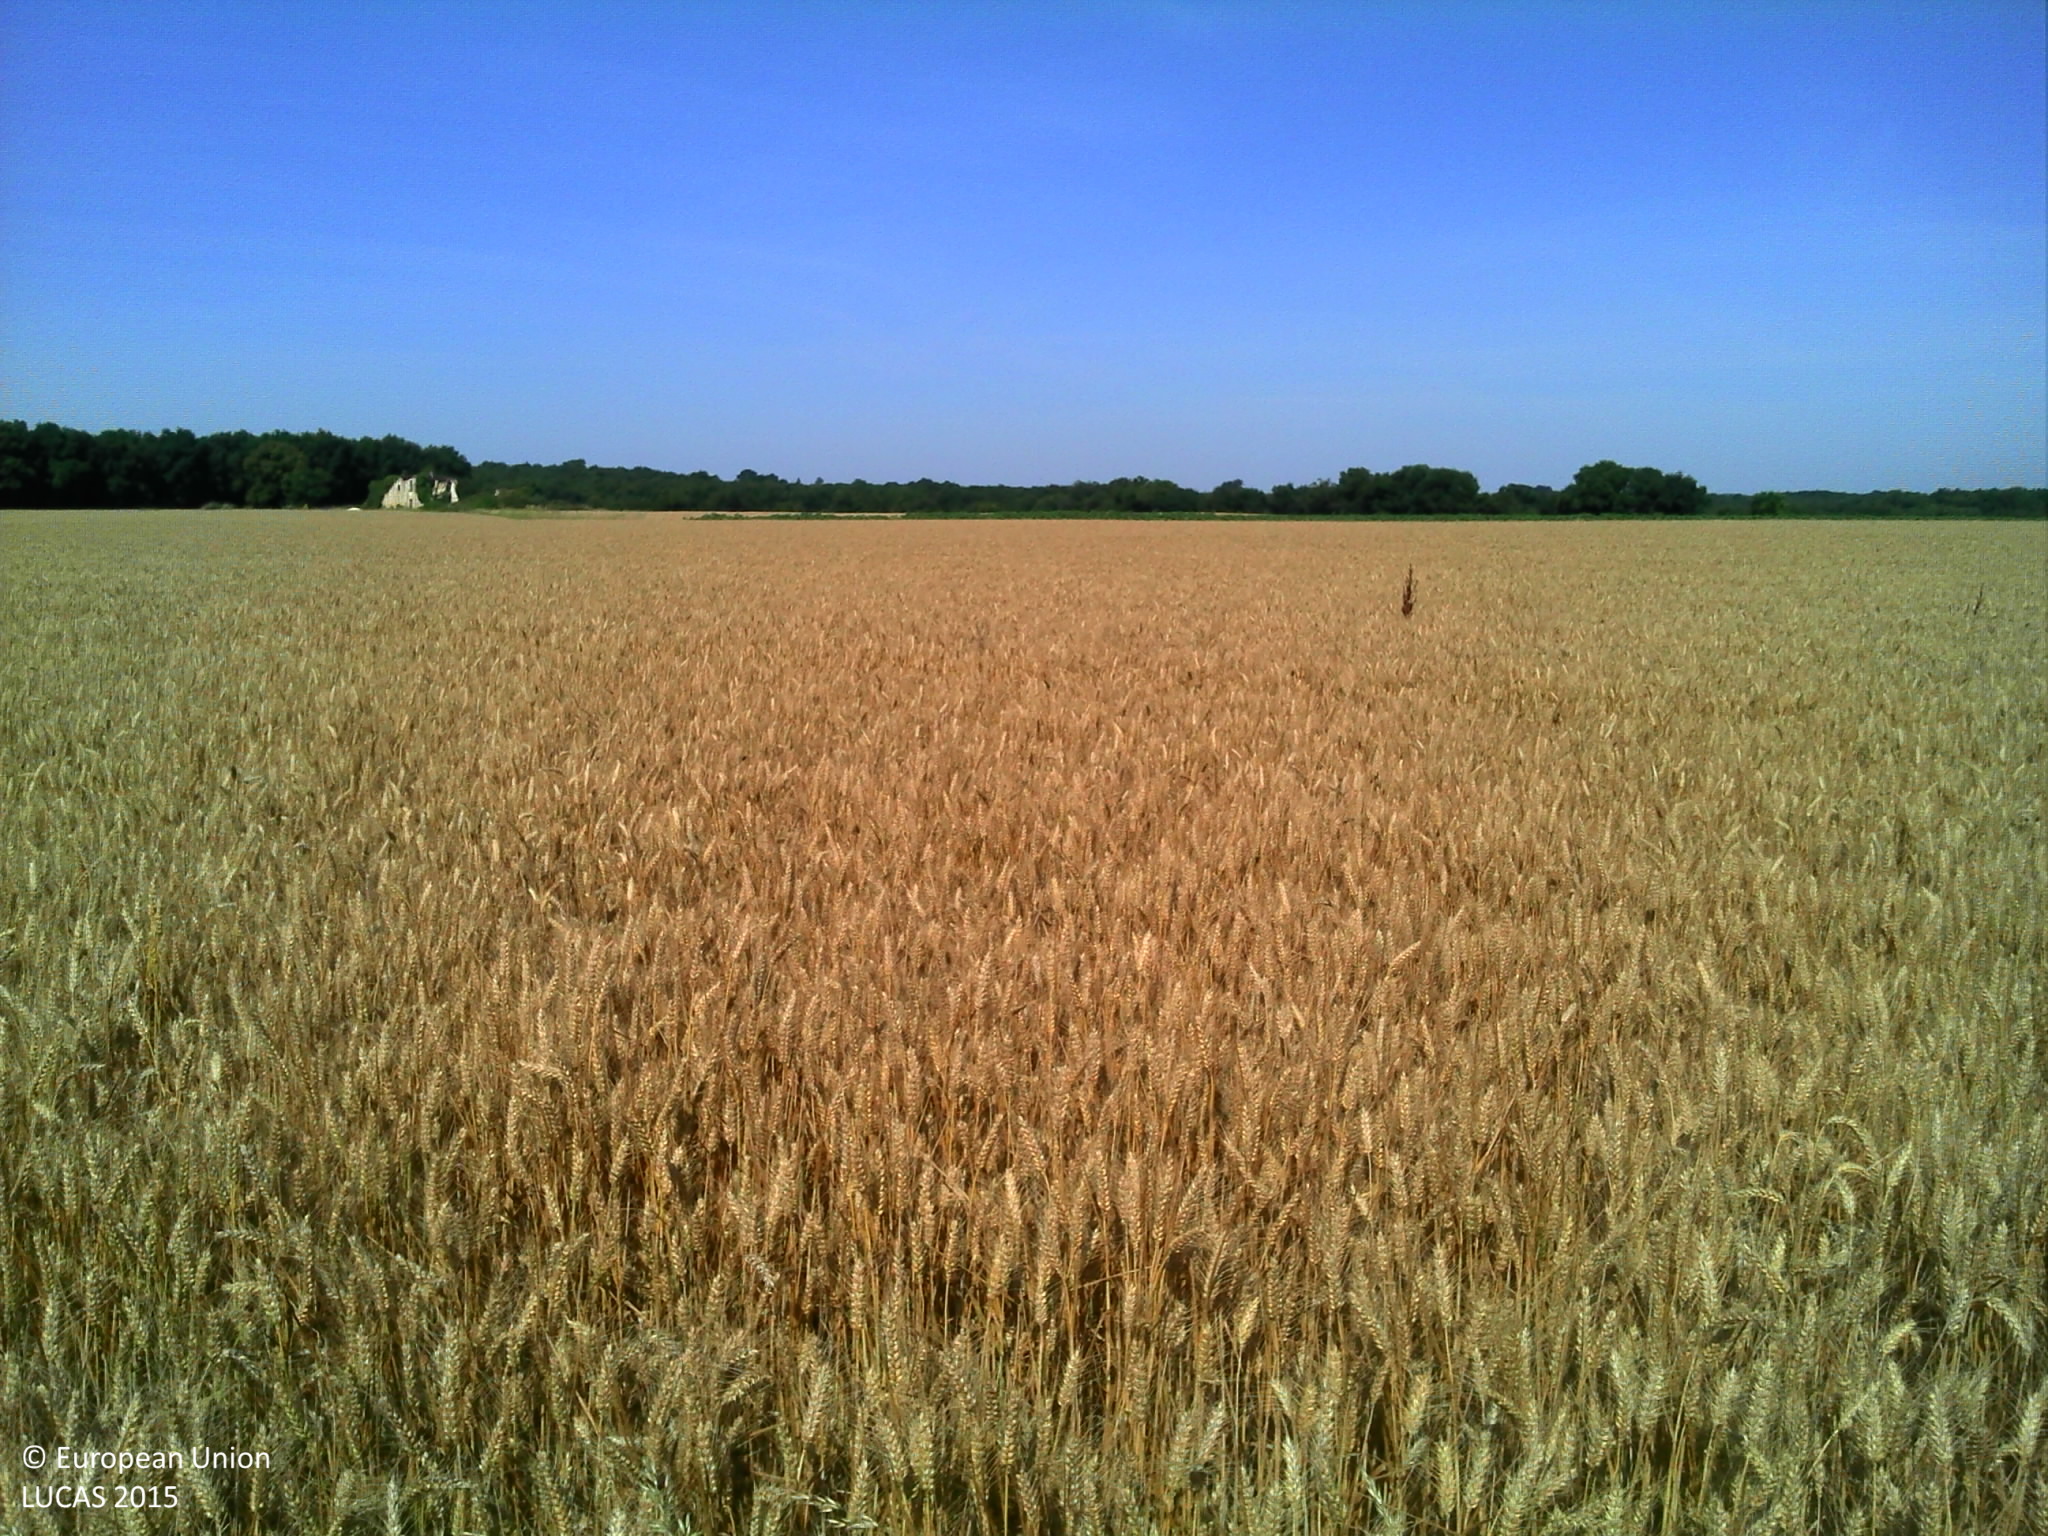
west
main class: Cropland
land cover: Durum wheat
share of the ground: > 75 %
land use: Agriculture (excluding fallow land and kitchen gardens)
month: June
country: FR
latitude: 45.8109
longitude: -0.7192
